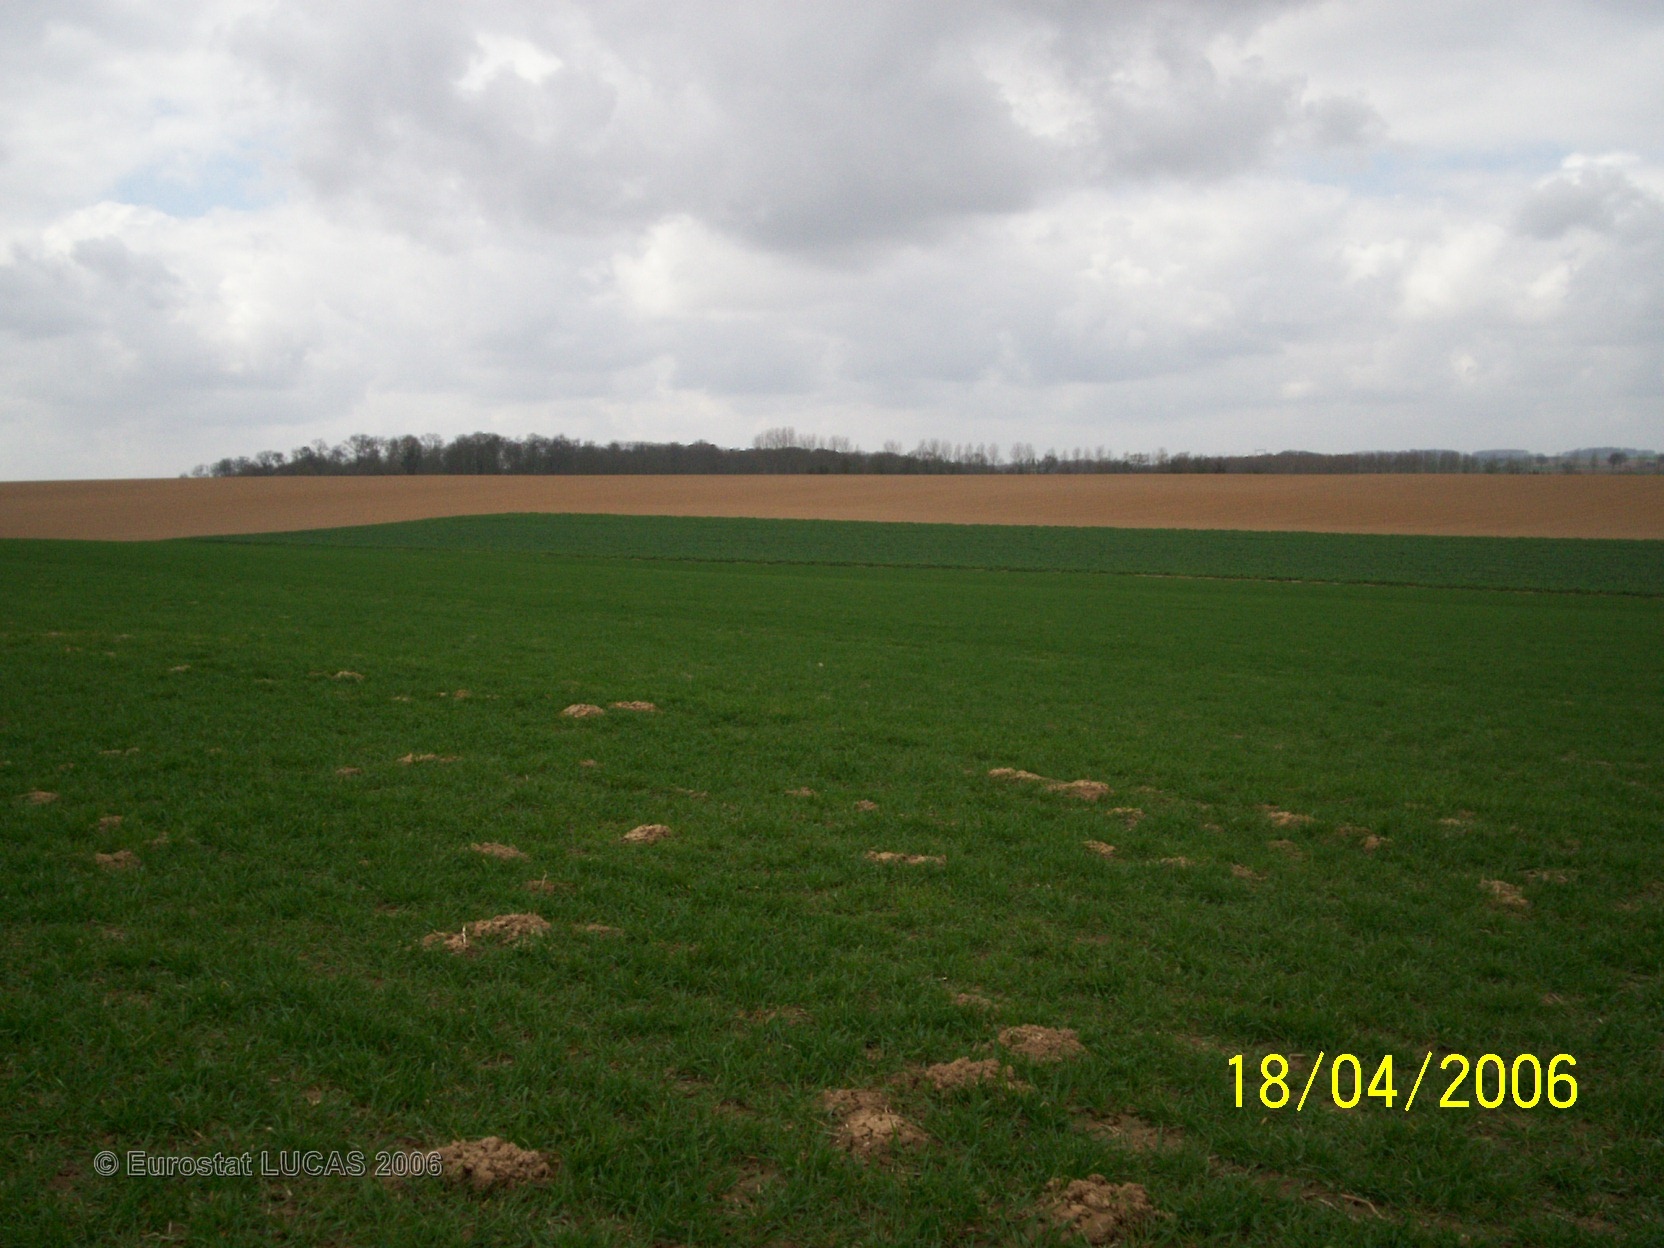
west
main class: Cropland
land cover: Common wheat
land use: Agriculture (excluding fallow land and kitchen gardens)
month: April
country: FR
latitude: 50.3380
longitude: 2.5552
